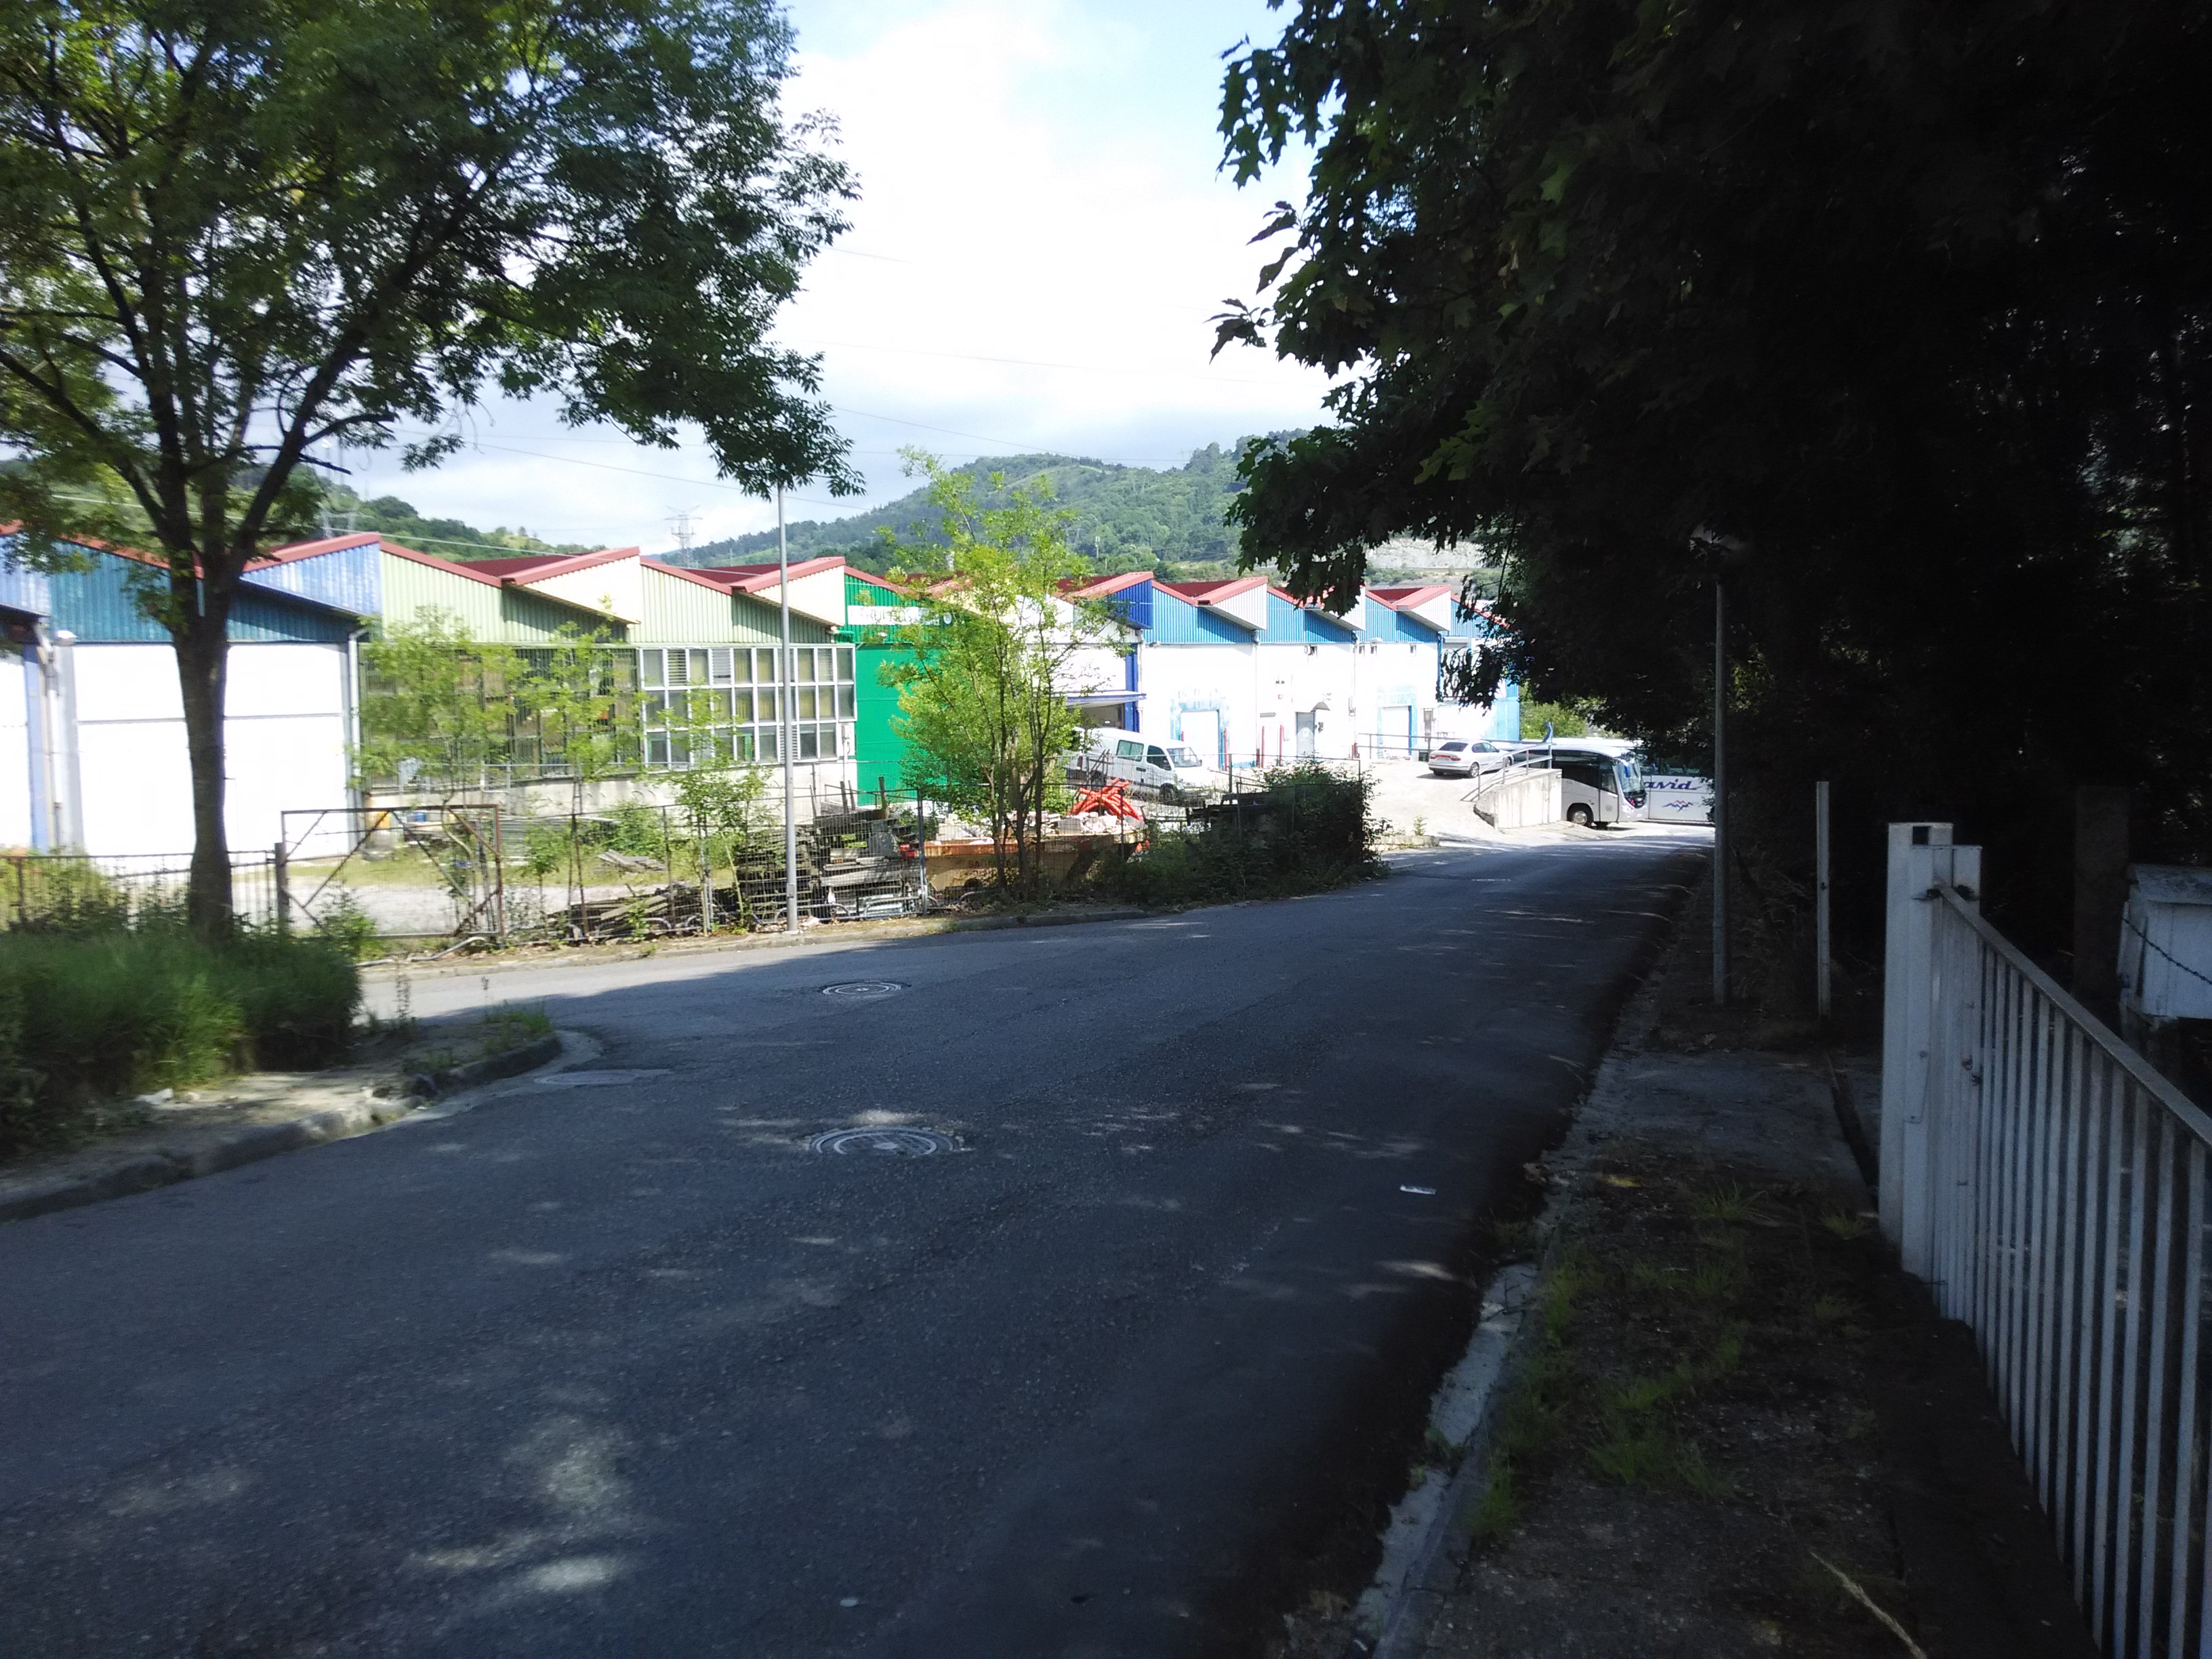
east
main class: Woodland
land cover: Broadleaved woodland
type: acidophilous oak and oak-birch forest
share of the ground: > 75 %
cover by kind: broadleaved forest trees 95 %, herbaceous plants 5 %
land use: Forestry
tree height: > 5 m
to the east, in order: Broadleaved woodland; Grassland without tree/shrub cover; Tracks; Other fresh vegetables; Grassland without tree/shrub cover; Electric lines; Grassland without tree/shrub cover; Artificial constructions in urban areas; Groves; Railways
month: June
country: ES
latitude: 43.3204
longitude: -1.8713
